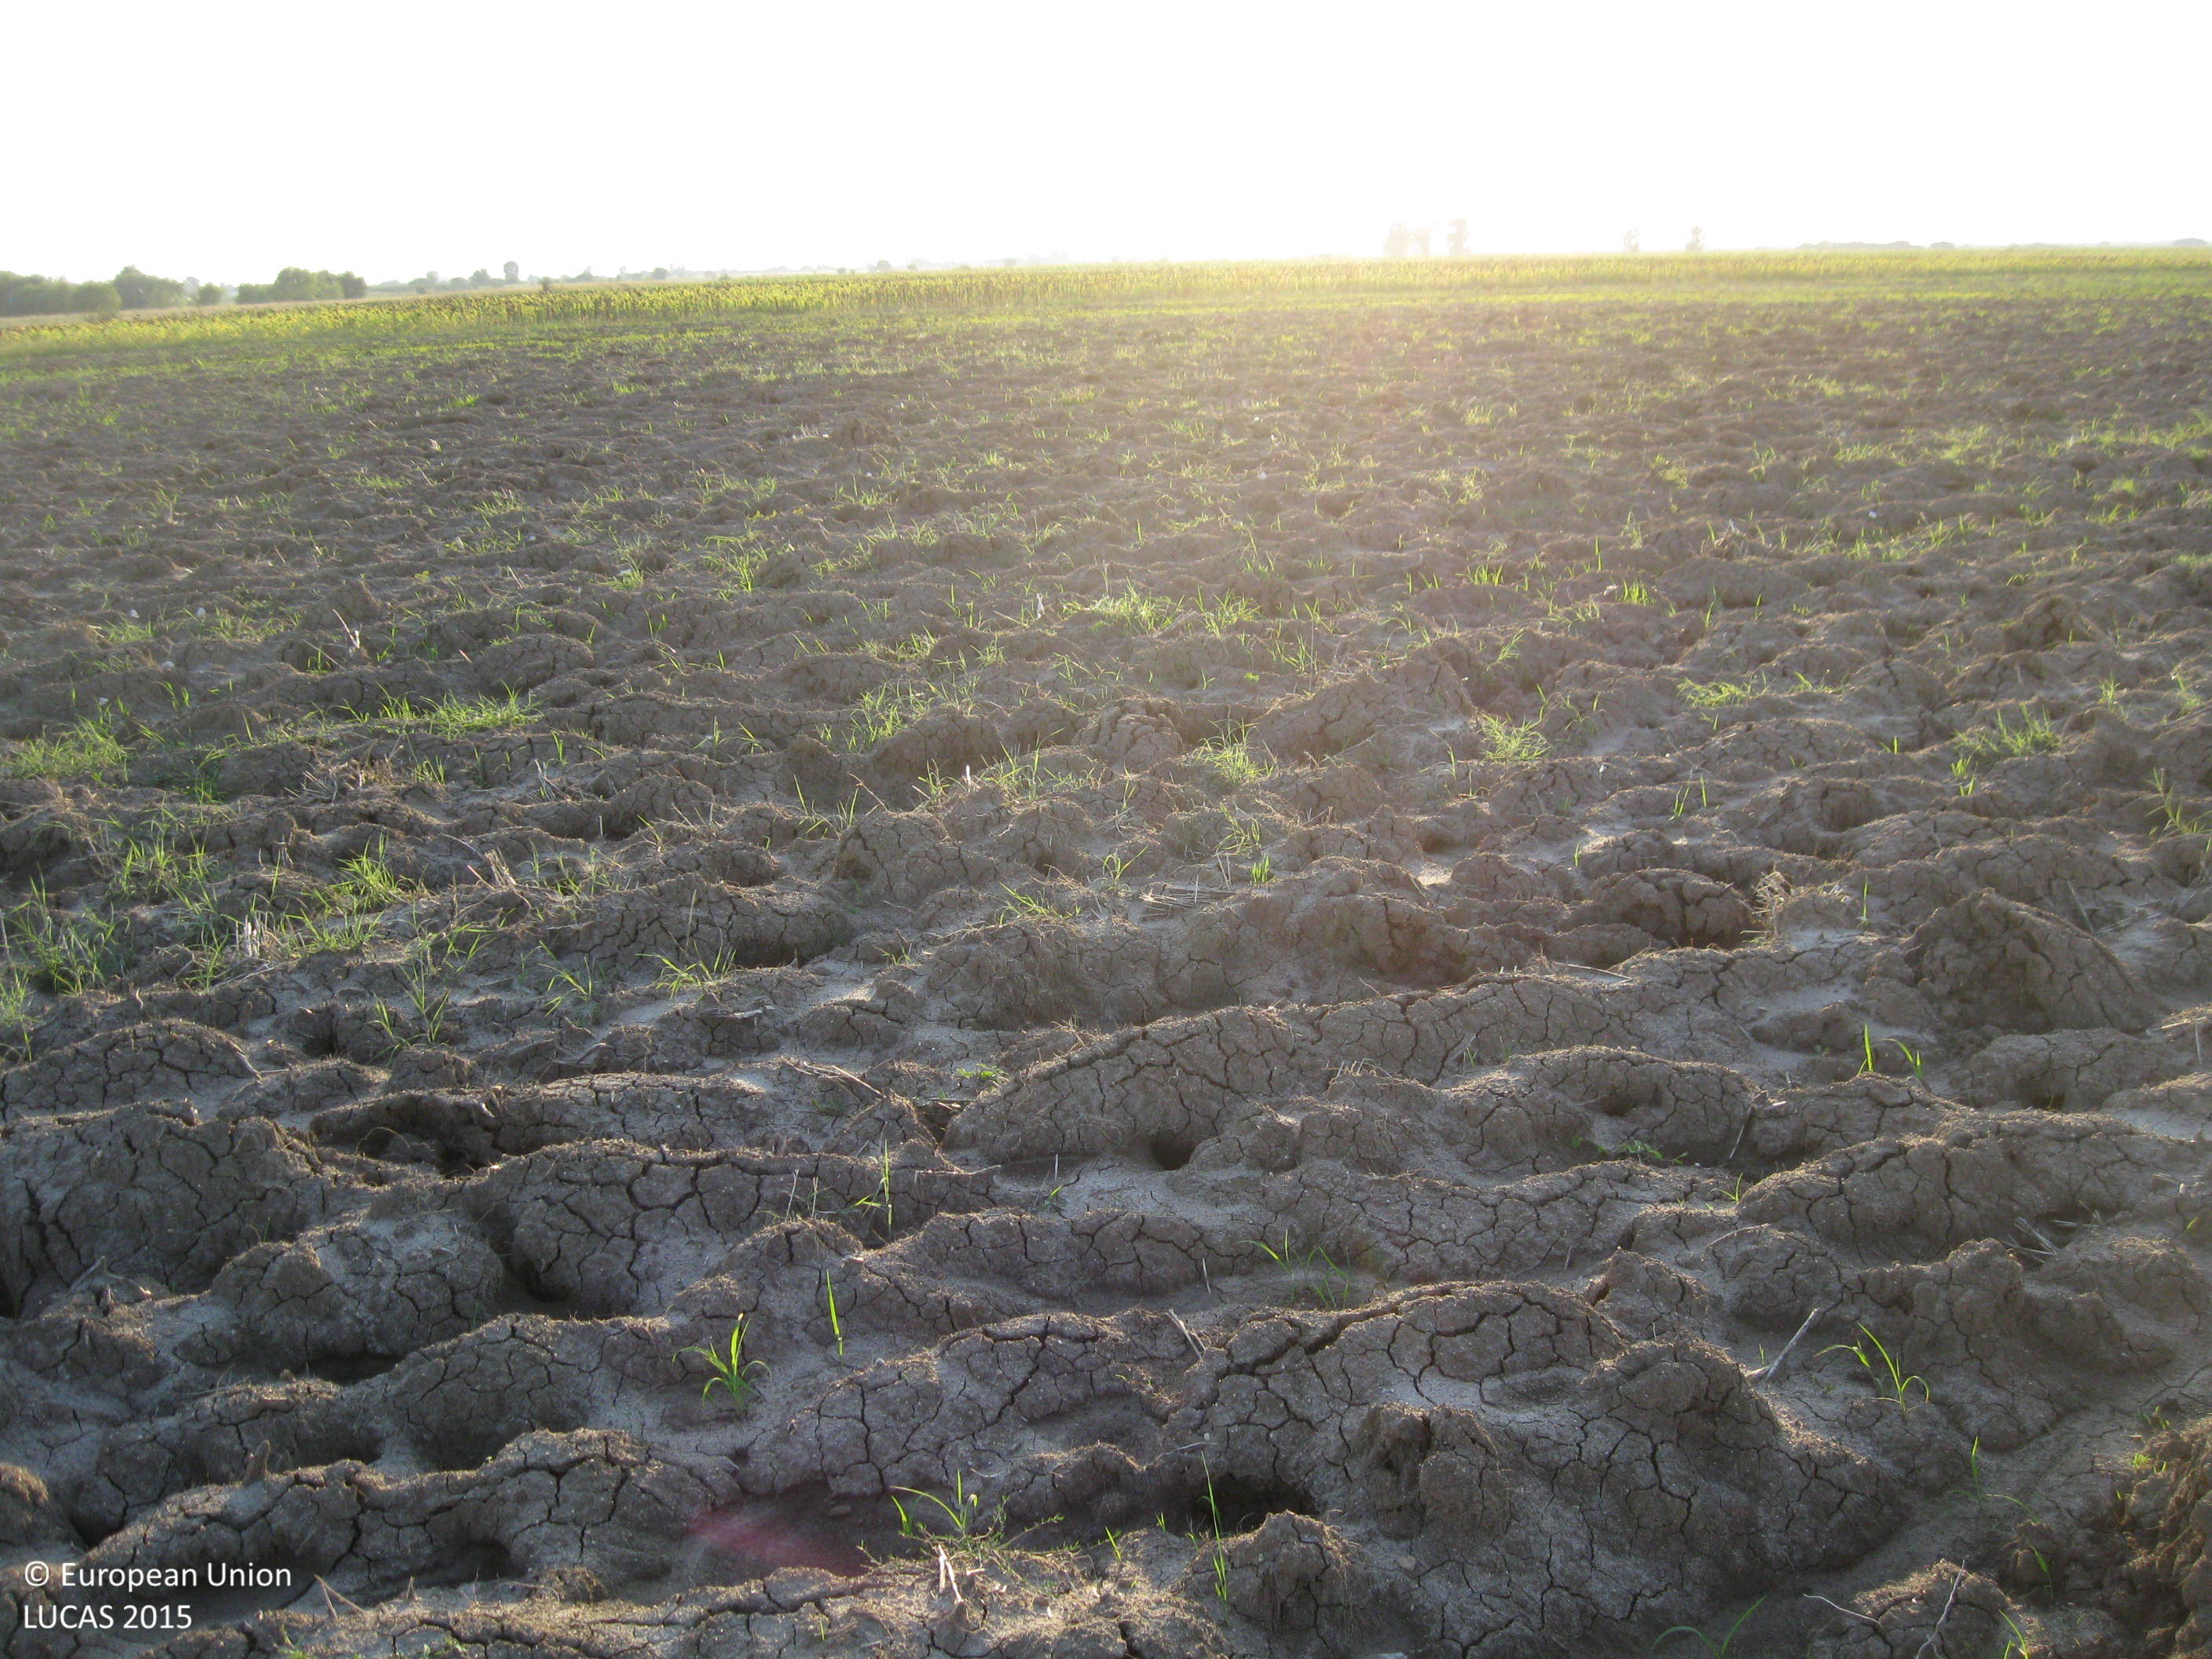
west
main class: Cropland
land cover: Common wheat
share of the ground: < 10 %
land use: Agriculture (excluding fallow land and kitchen gardens)
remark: Harvested field
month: August
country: BG
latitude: 42.1989
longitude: 24.9395
